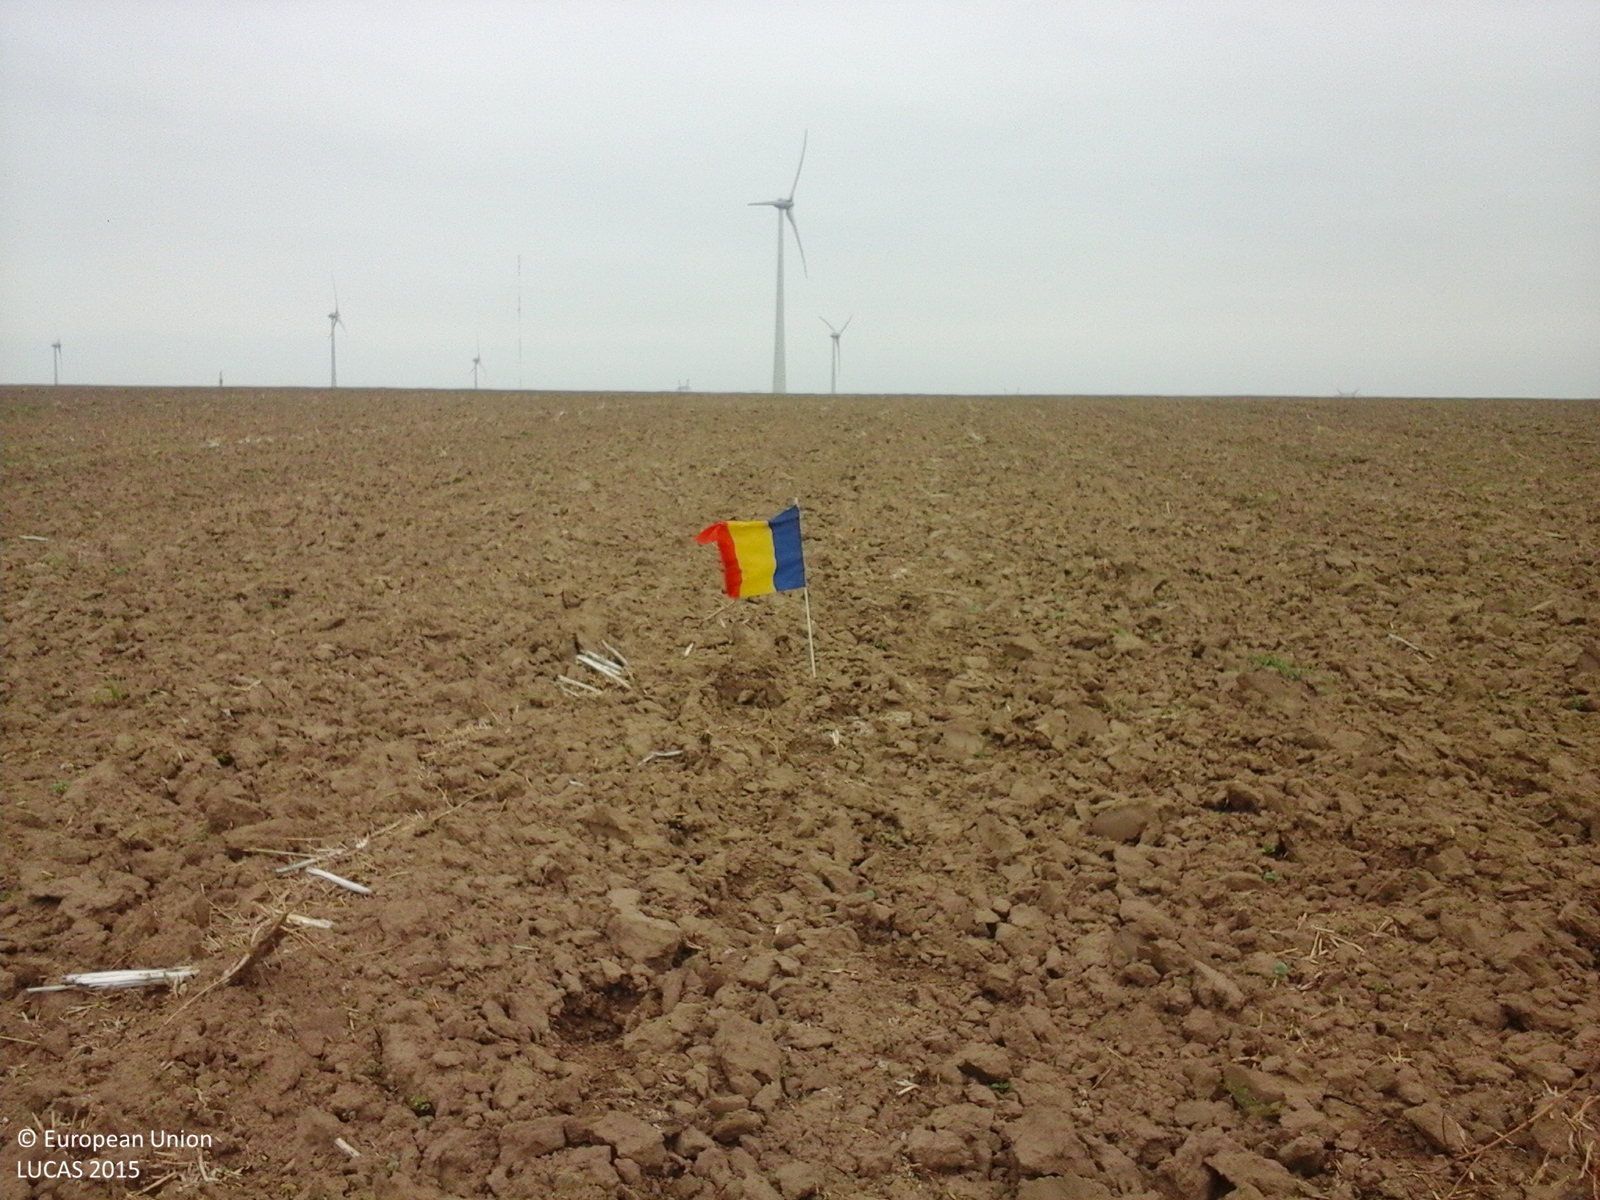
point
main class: Cropland
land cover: Rape and turnip rape
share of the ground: < 10 %
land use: Agriculture (excluding fallow land and kitchen gardens)
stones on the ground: < 10 %
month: August
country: RO
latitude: 44.8162
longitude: 28.2656
